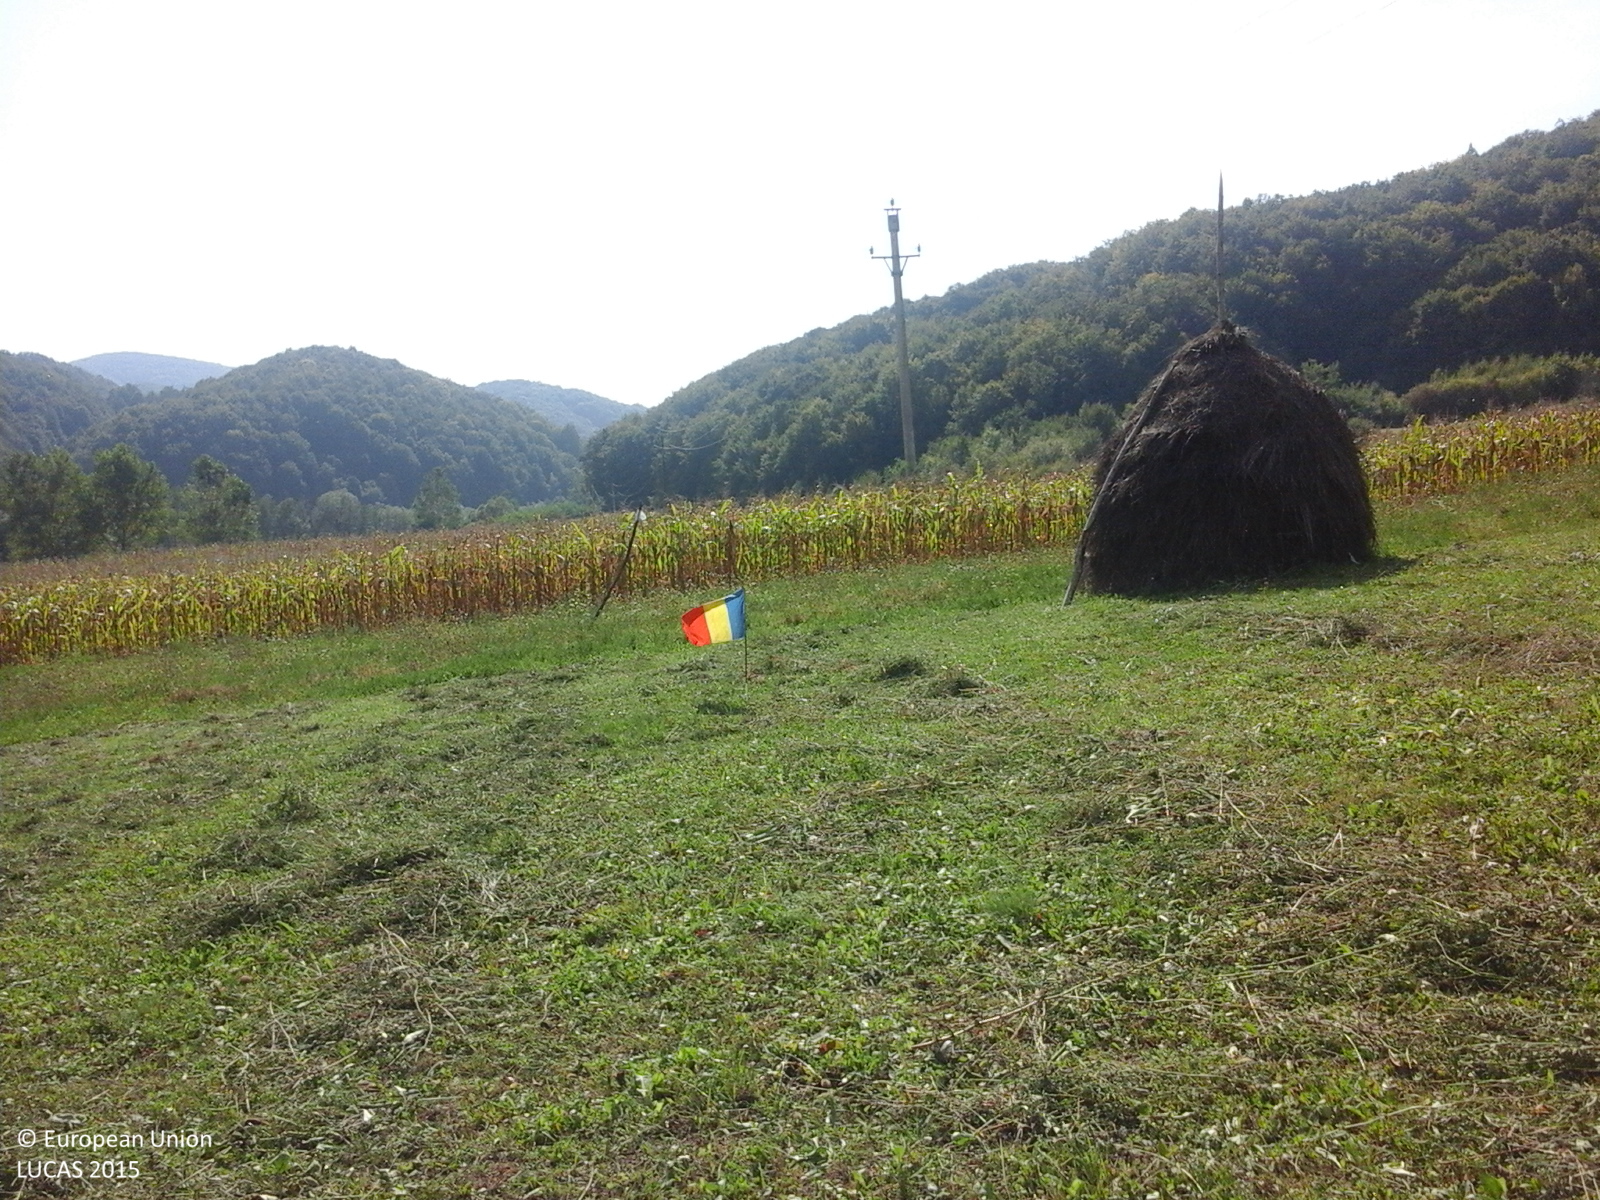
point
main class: Grassland
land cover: Grassland without tree/shrub cover
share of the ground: > 75 %
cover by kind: herbaceous plants 100 %
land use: Agriculture (excluding fallow land and kitchen gardens)
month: September
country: RO
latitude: 47.3177
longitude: 23.7704
